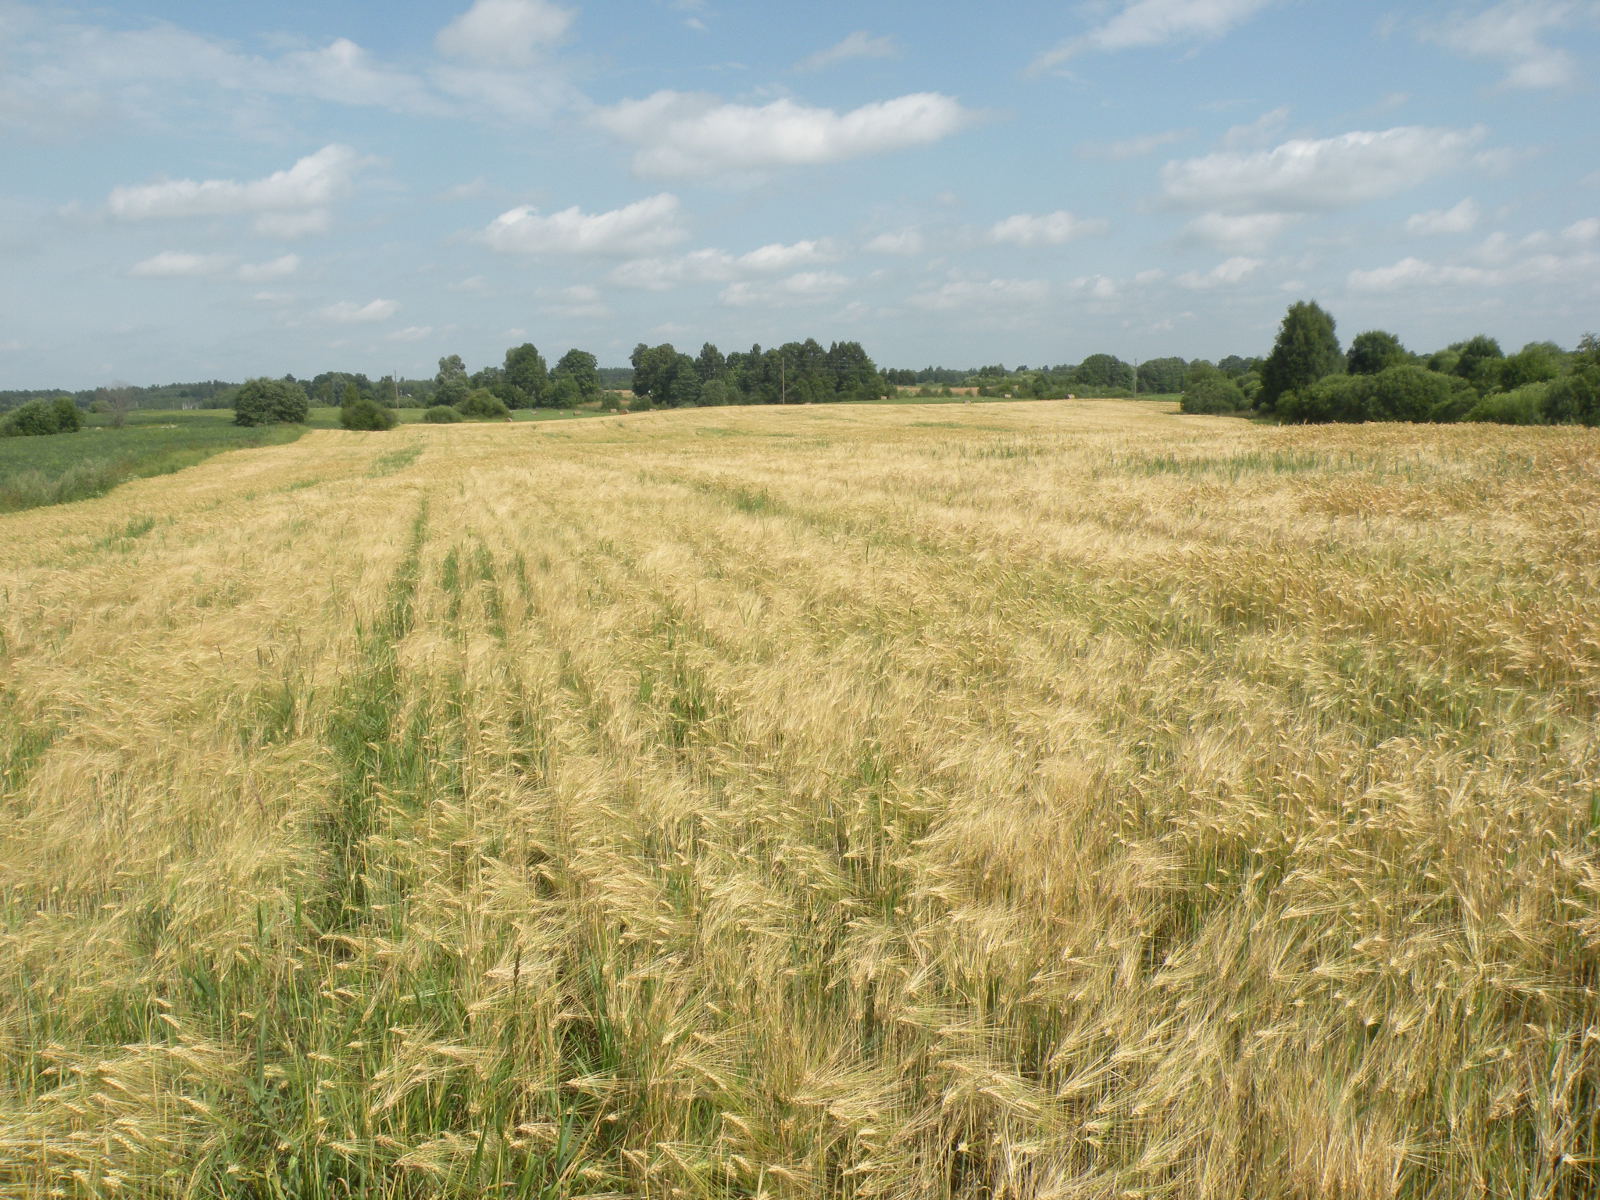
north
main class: Cropland
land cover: Barley
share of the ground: > 75 %
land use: Agriculture (excluding fallow land and kitchen gardens)
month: July
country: LV
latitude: 55.8518
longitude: 26.7220
